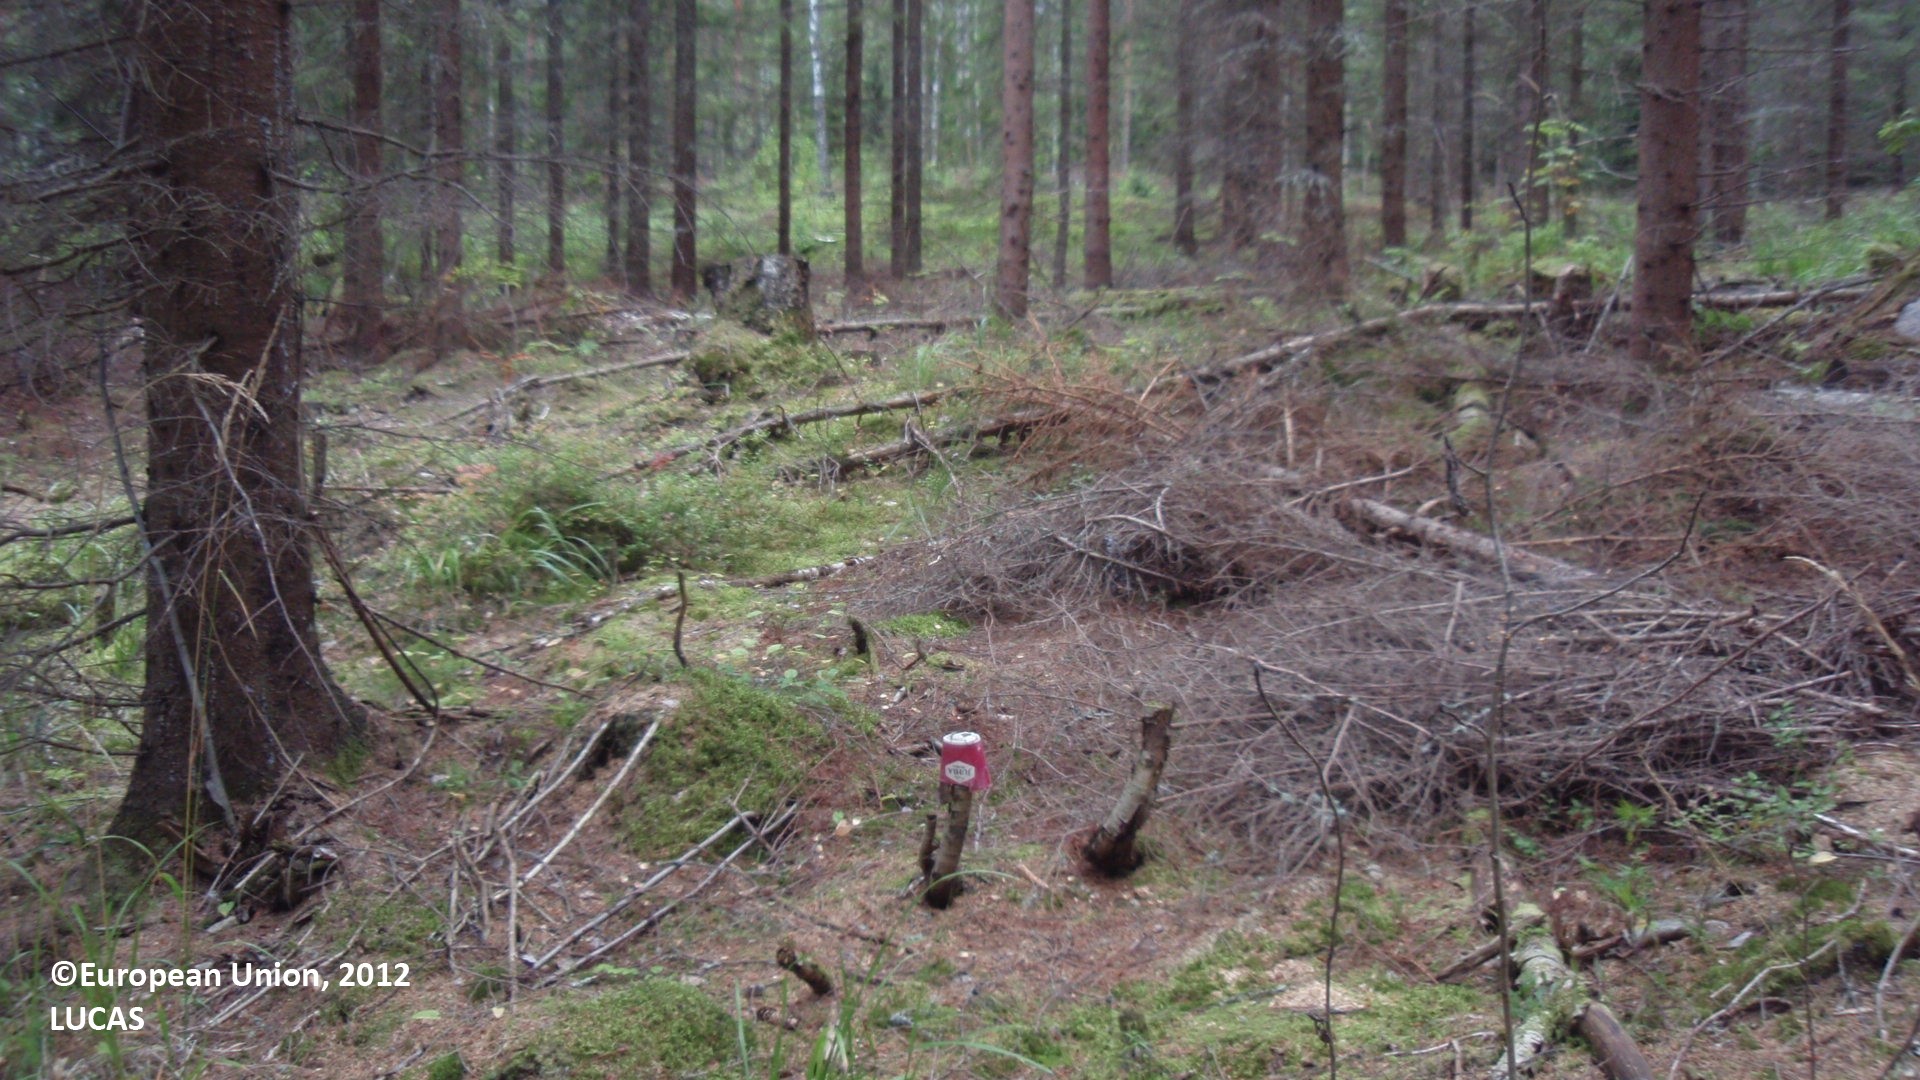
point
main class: Woodland
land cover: Spruce dominated coniferous woodland
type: boreal forest
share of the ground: 50 - 75 %
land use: Forestry
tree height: > 5 m
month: August
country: FI
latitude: 61.1798
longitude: 26.6109
